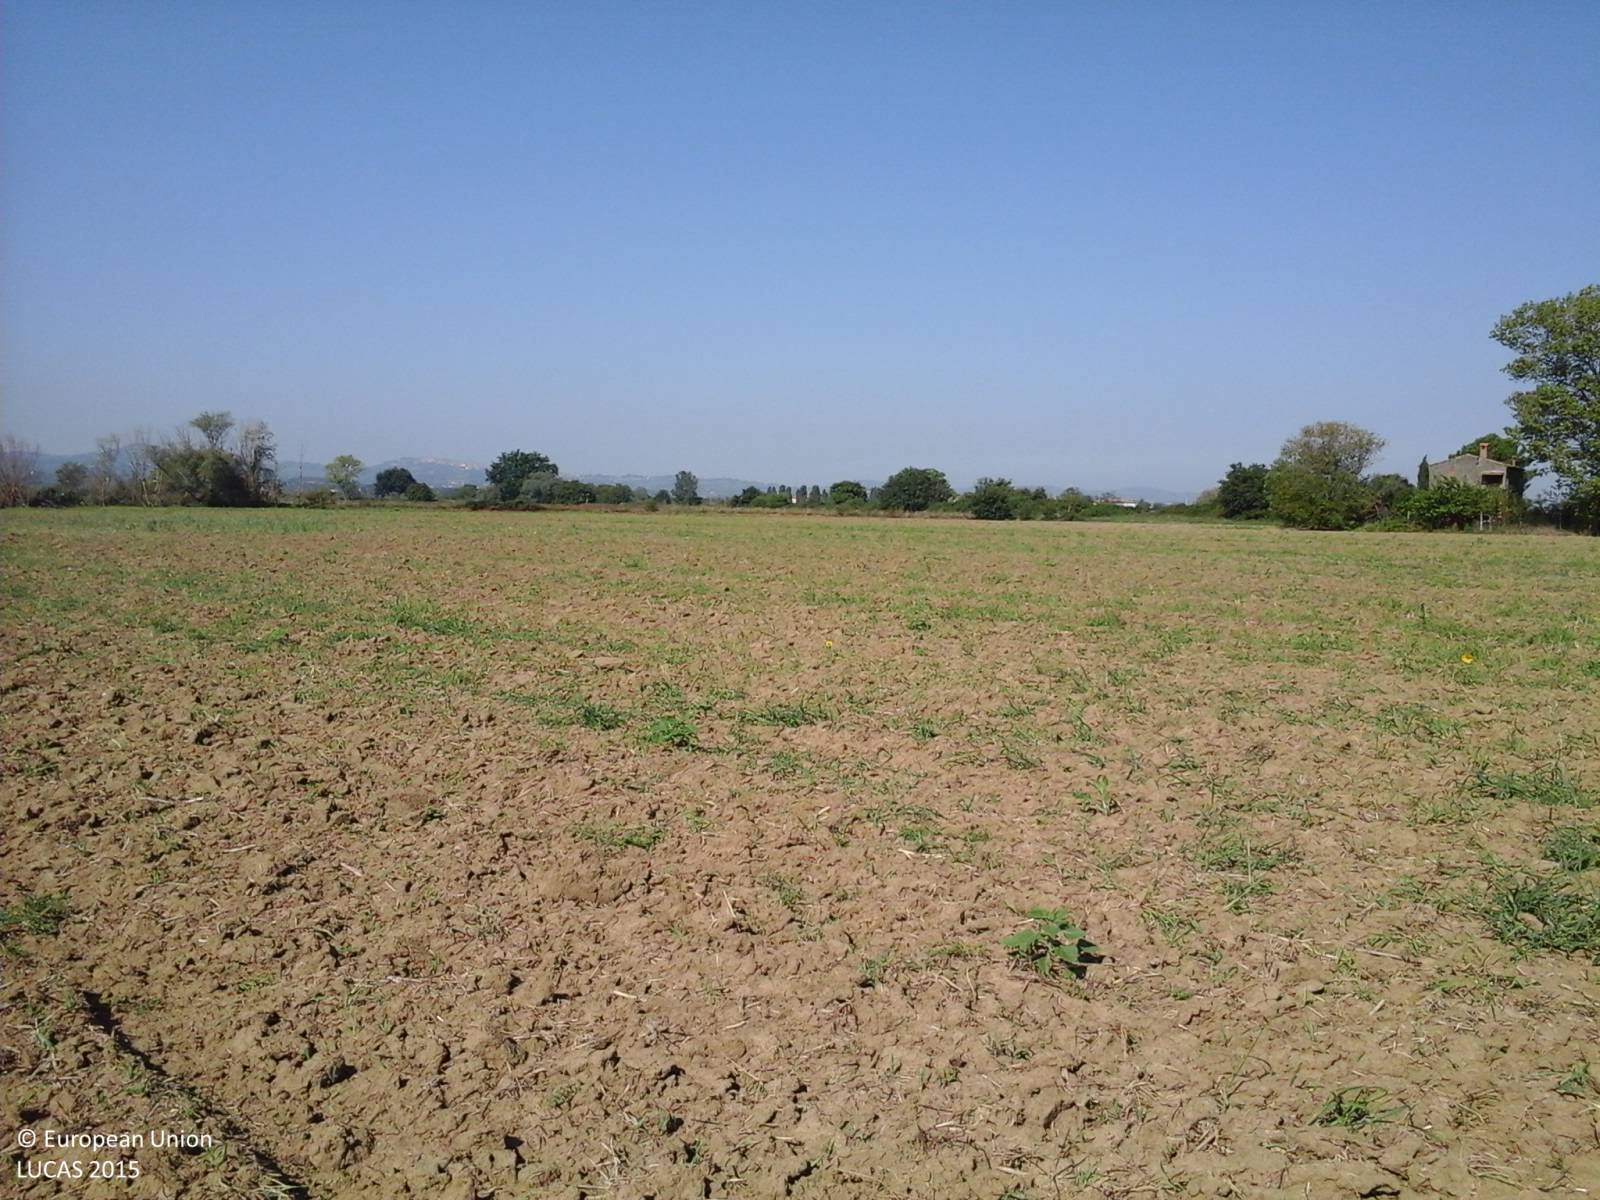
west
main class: Woodland
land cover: Broadleaved woodland
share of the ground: 25 - 50 %
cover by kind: broadleaved forest trees 75 %, shrubs 25 %
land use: Semi-natural and natural areas not in use
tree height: > 5 m
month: September
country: IT
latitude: 43.0198
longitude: 12.5326
